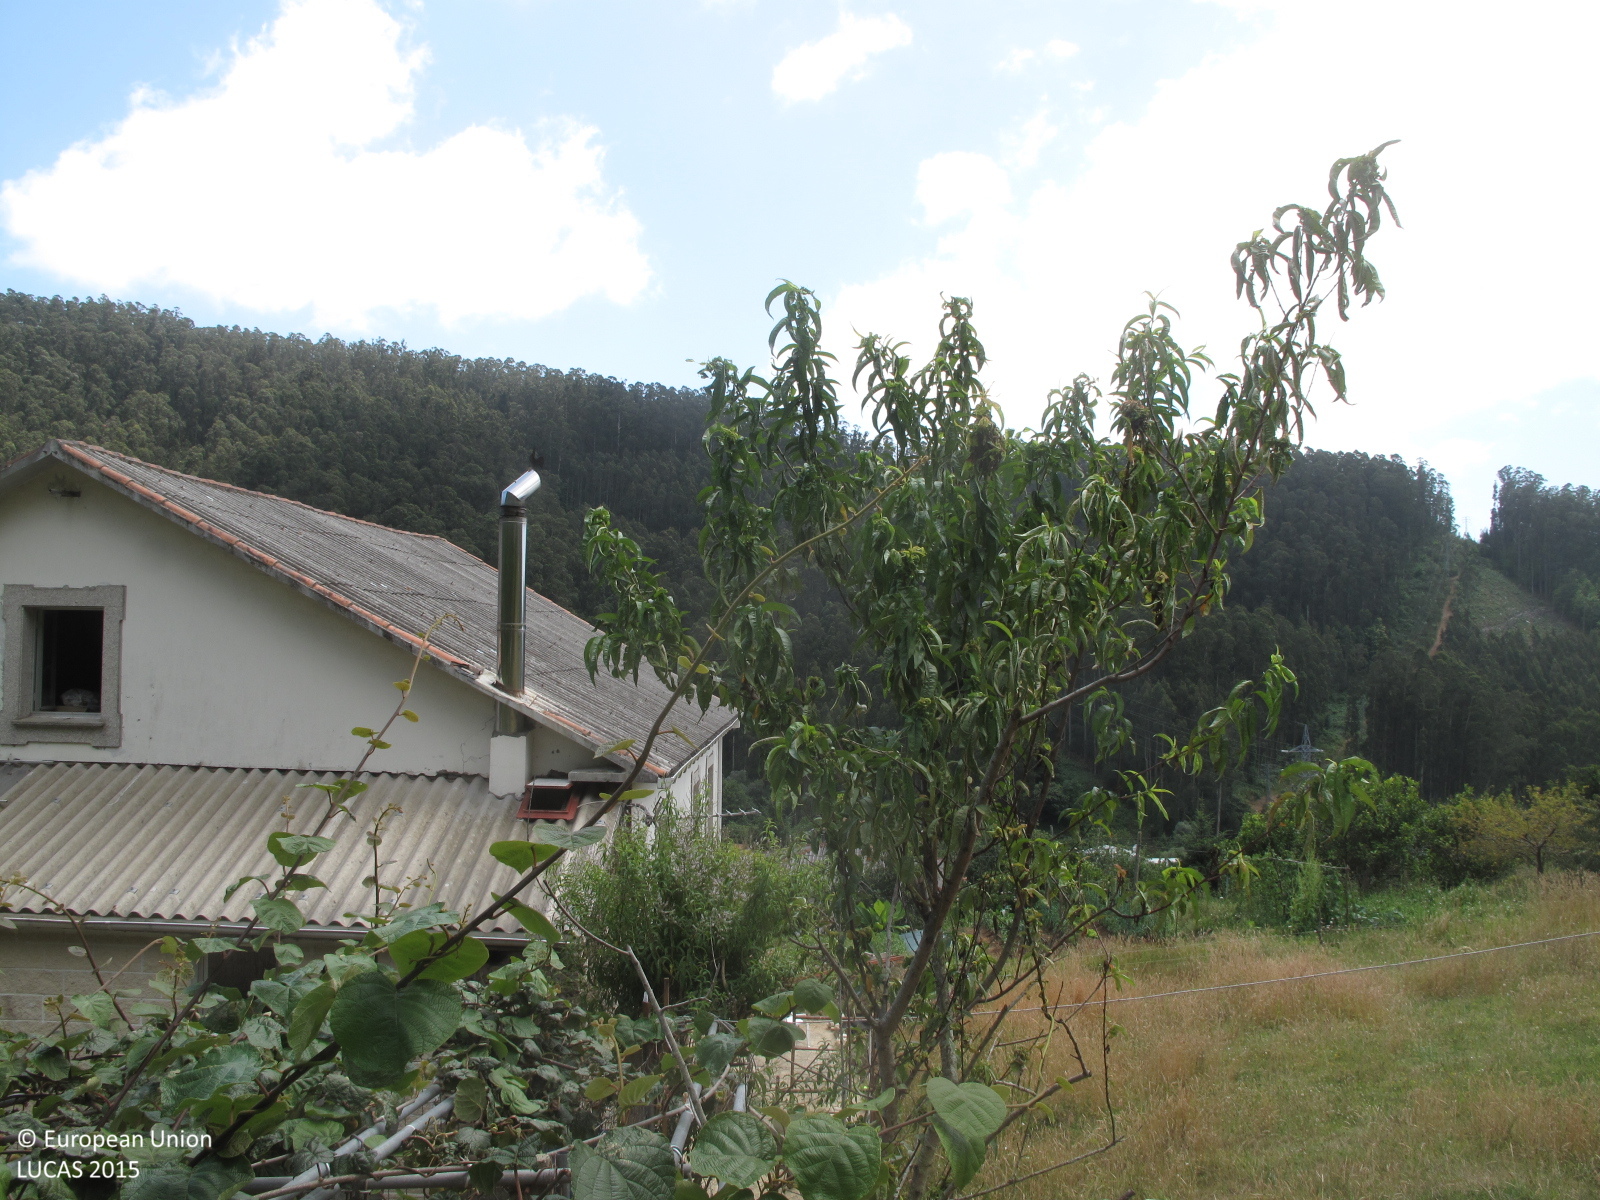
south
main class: Grassland
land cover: Grassland with sparse tree/shrub cover
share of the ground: > 75 %
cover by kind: herbaceous plants 95 %, broadleaved forest trees 5 %
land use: Residential
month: July
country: ES
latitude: 43.6395
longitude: -8.0360
